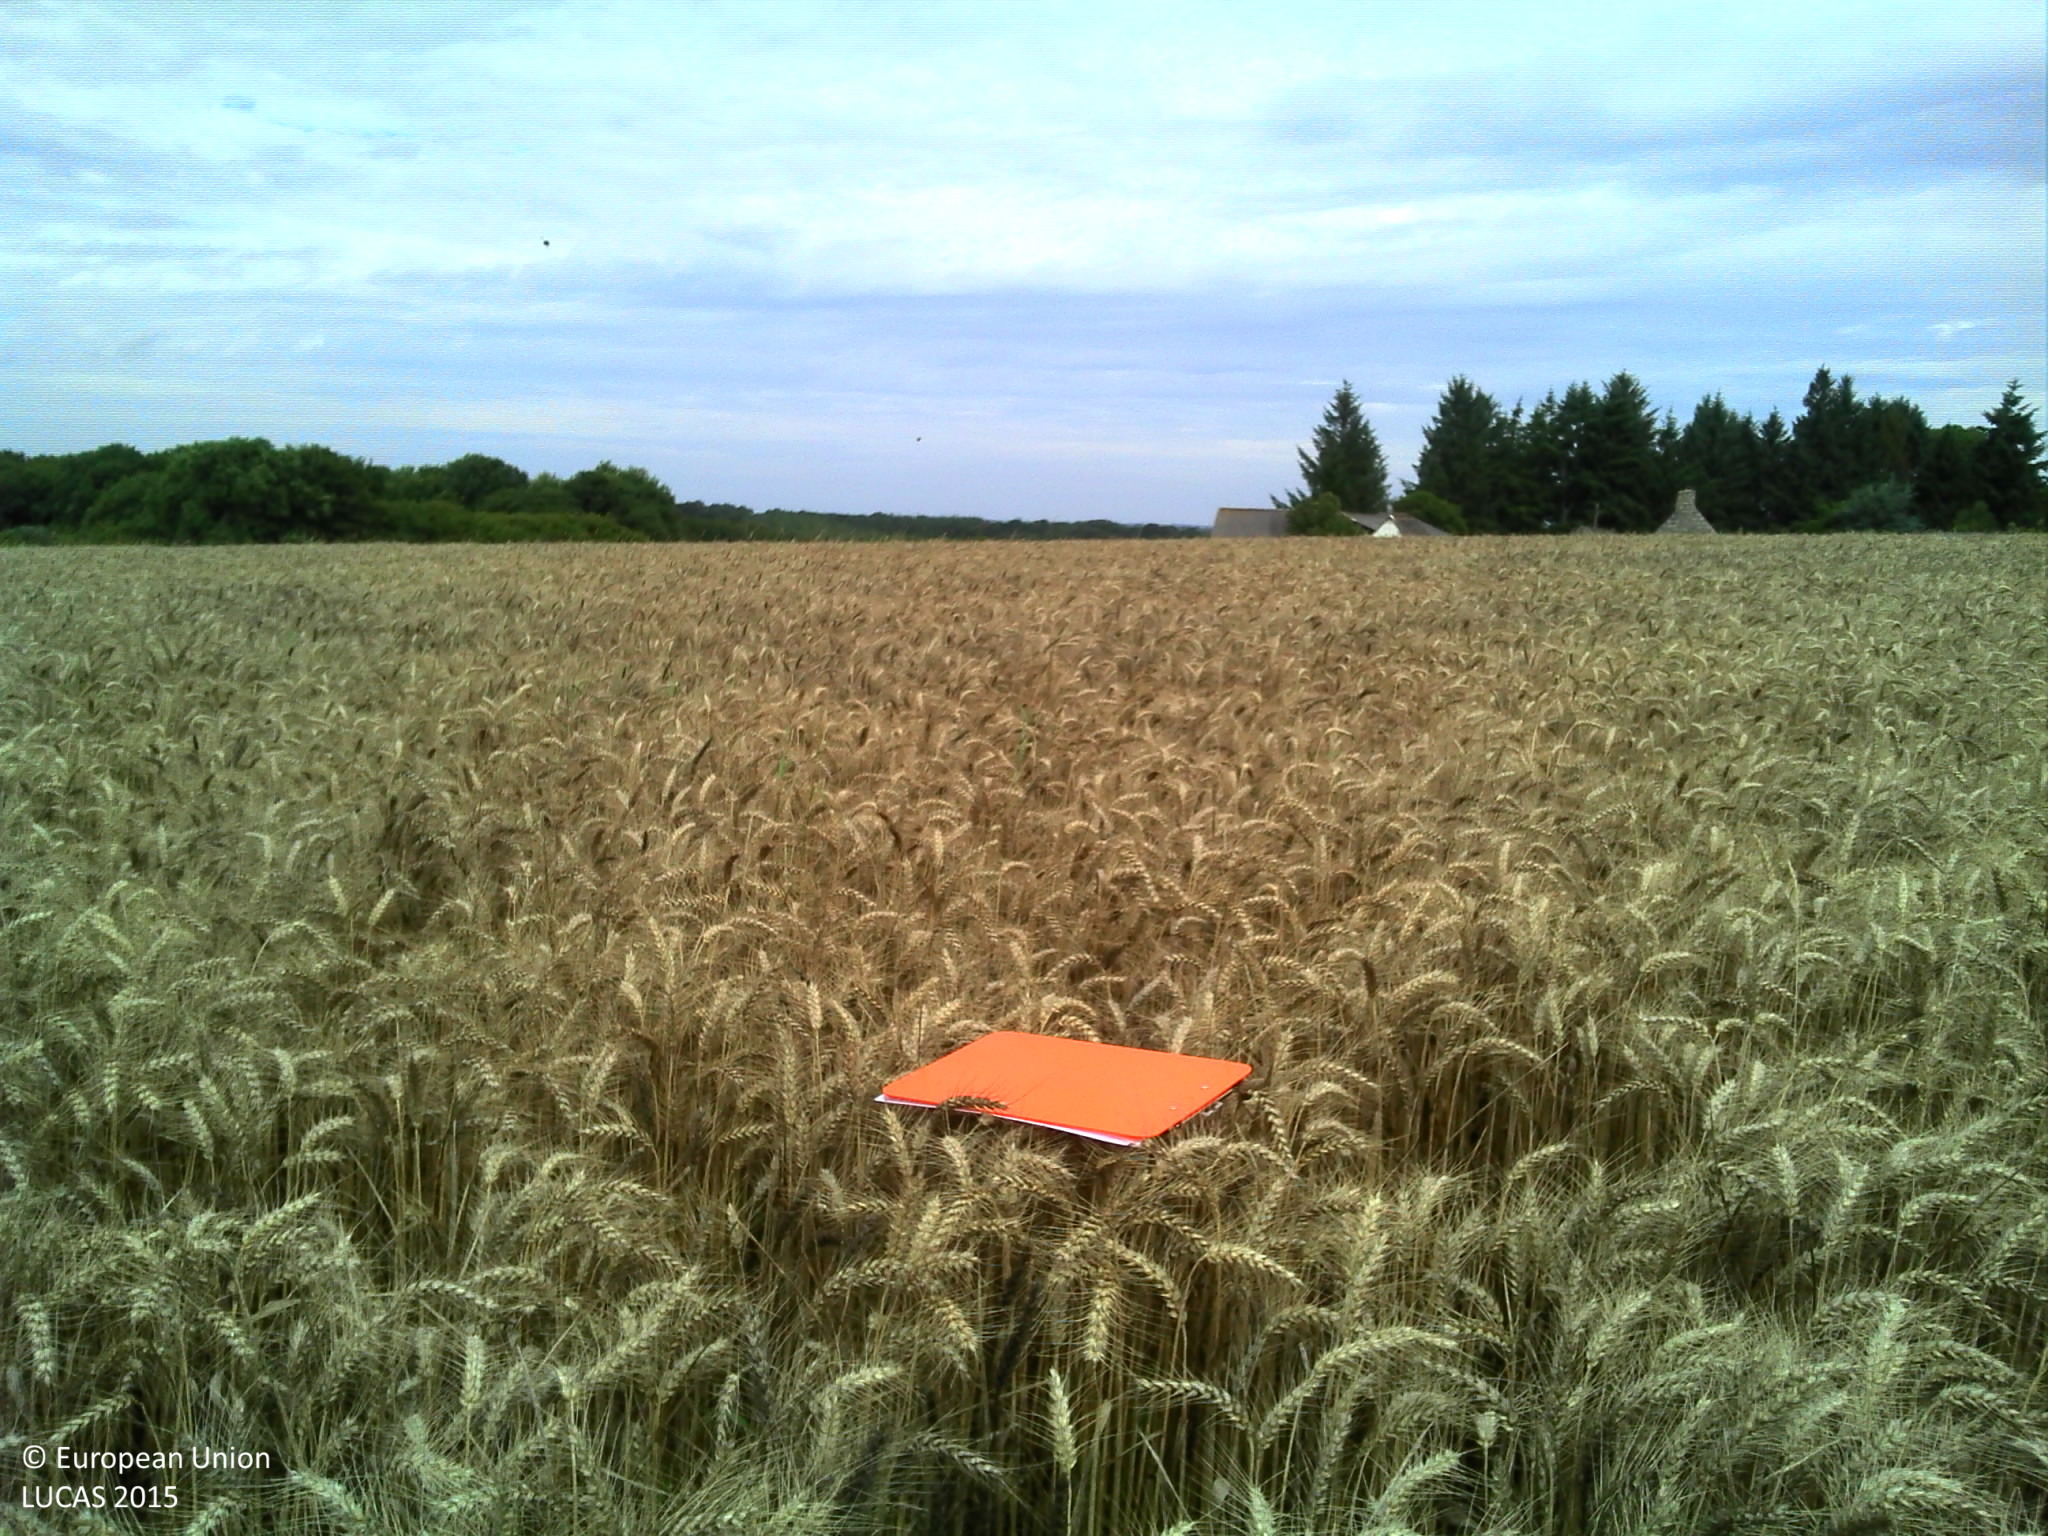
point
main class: Cropland
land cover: Common wheat
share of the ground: > 75 %
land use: Agriculture (excluding fallow land and kitchen gardens)
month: August
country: FR
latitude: 48.3211
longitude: -3.3322
